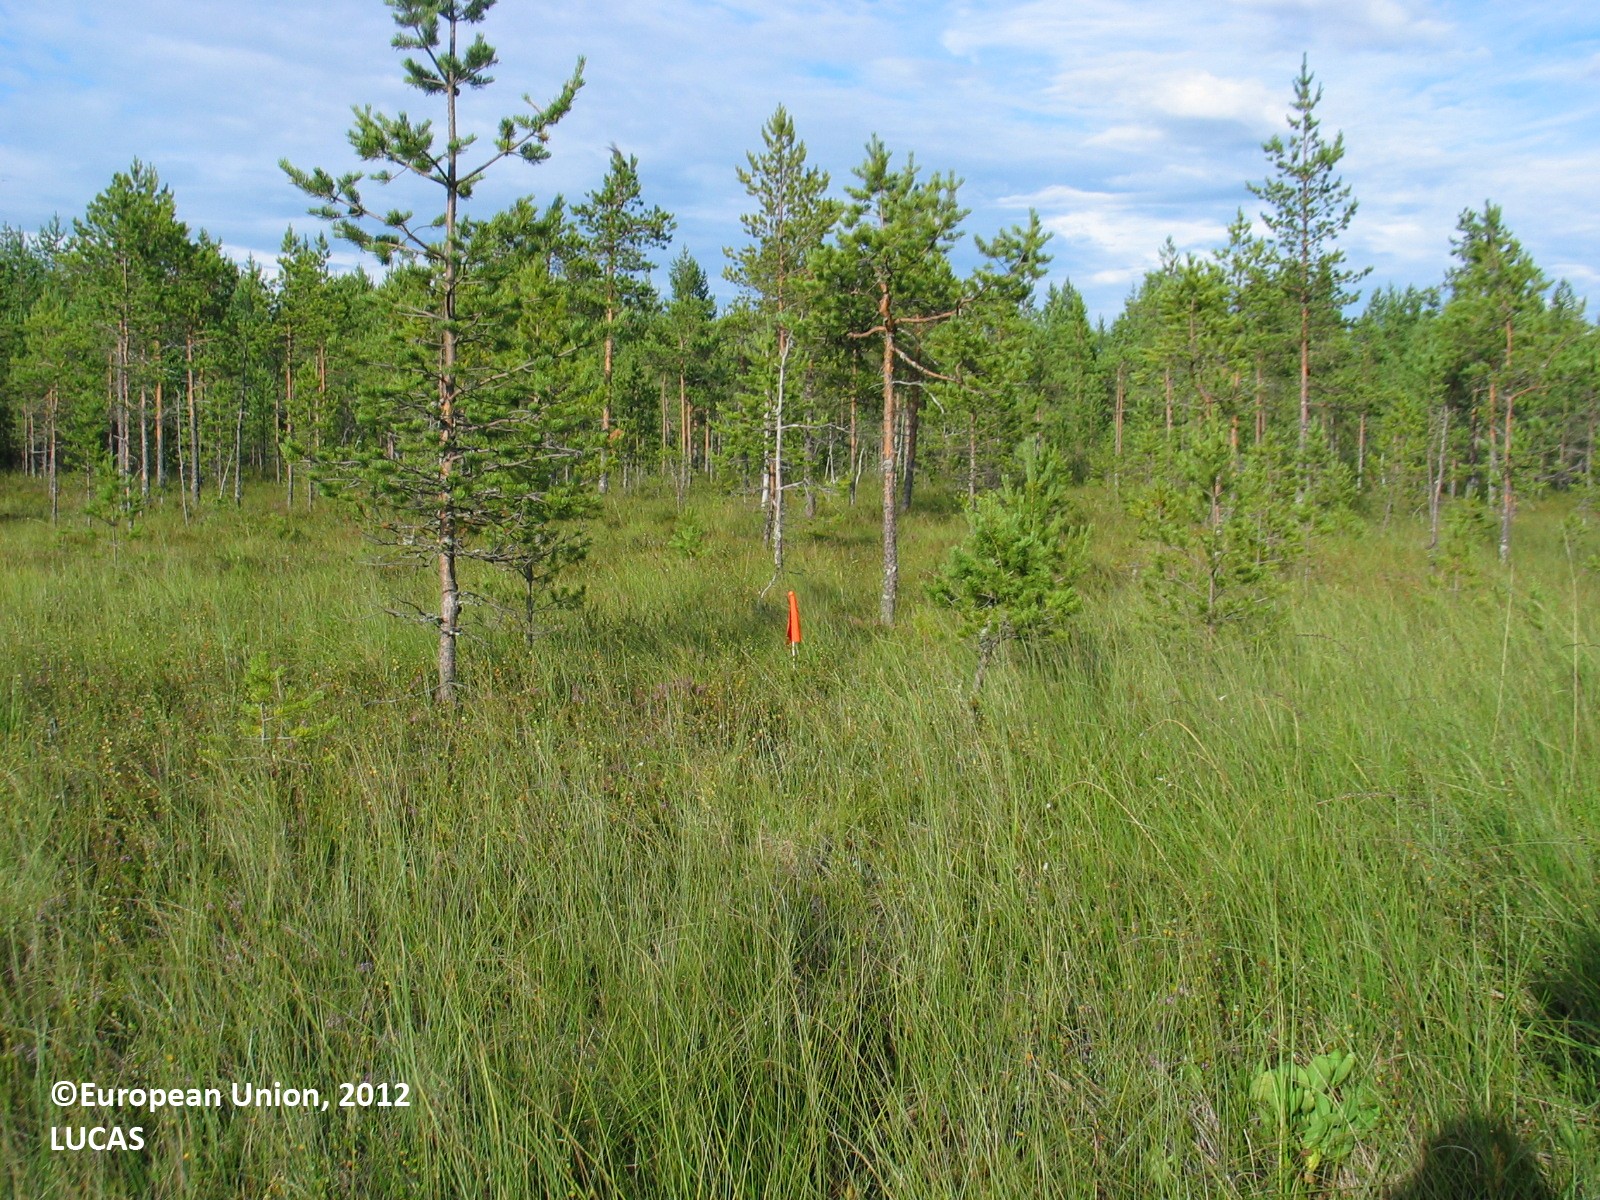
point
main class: Woodland
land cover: Pine dominated coniferous woodland
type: mire and swamp forests
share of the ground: 10 - 25 %
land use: Semi-natural and natural areas not in use
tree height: > 5 m
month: August
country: FI
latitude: 64.6102
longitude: 26.0504
